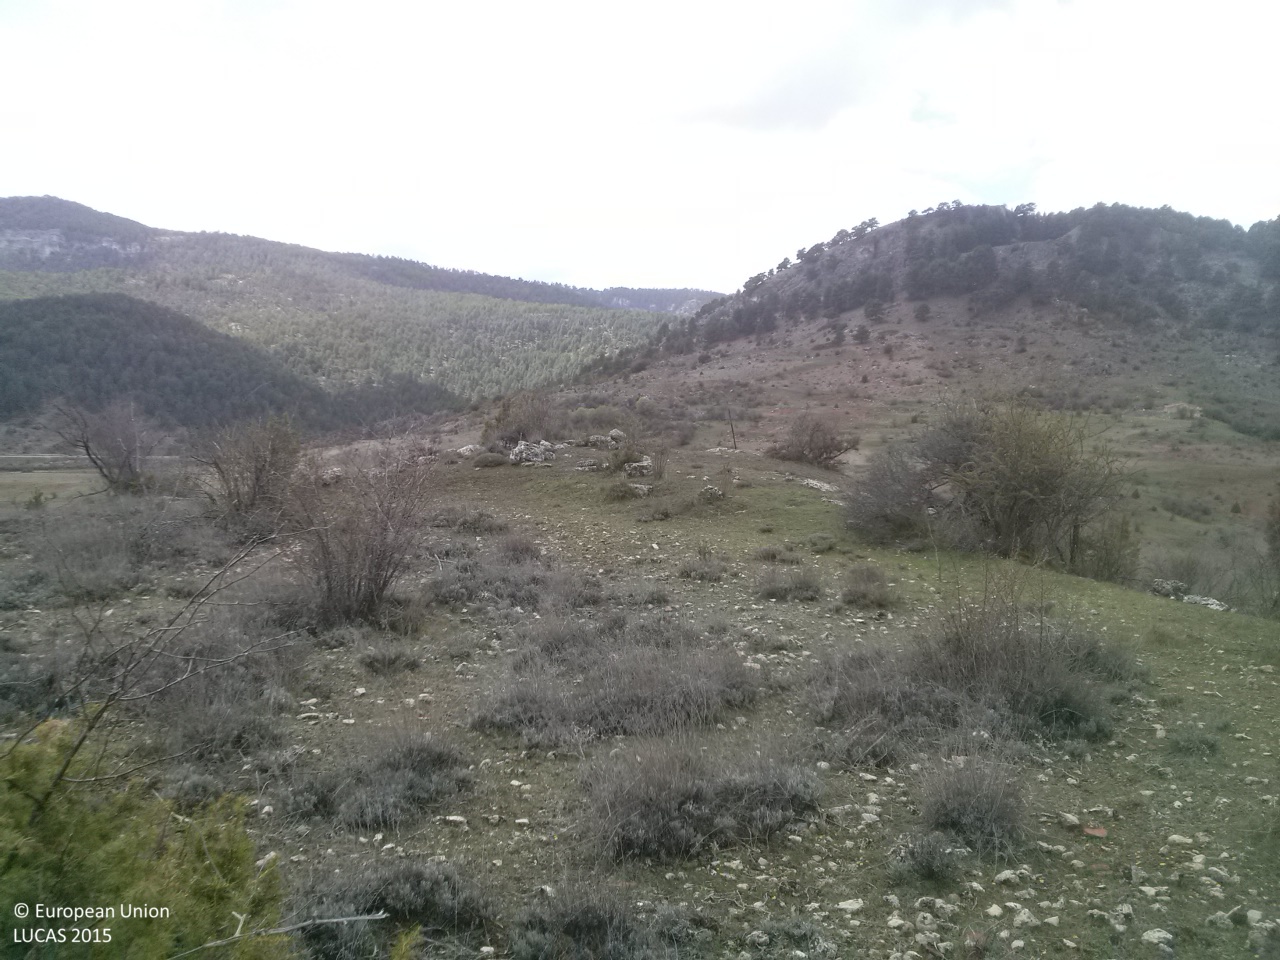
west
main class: Shrubland
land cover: Shrubland without tree cover
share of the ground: 25 - 50 %
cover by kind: shrubs 60 %, herbaceous plants 40 %
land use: Agriculture (excluding fallow land and kitchen gardens)
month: April
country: ES
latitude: 40.3681
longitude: -1.8523
